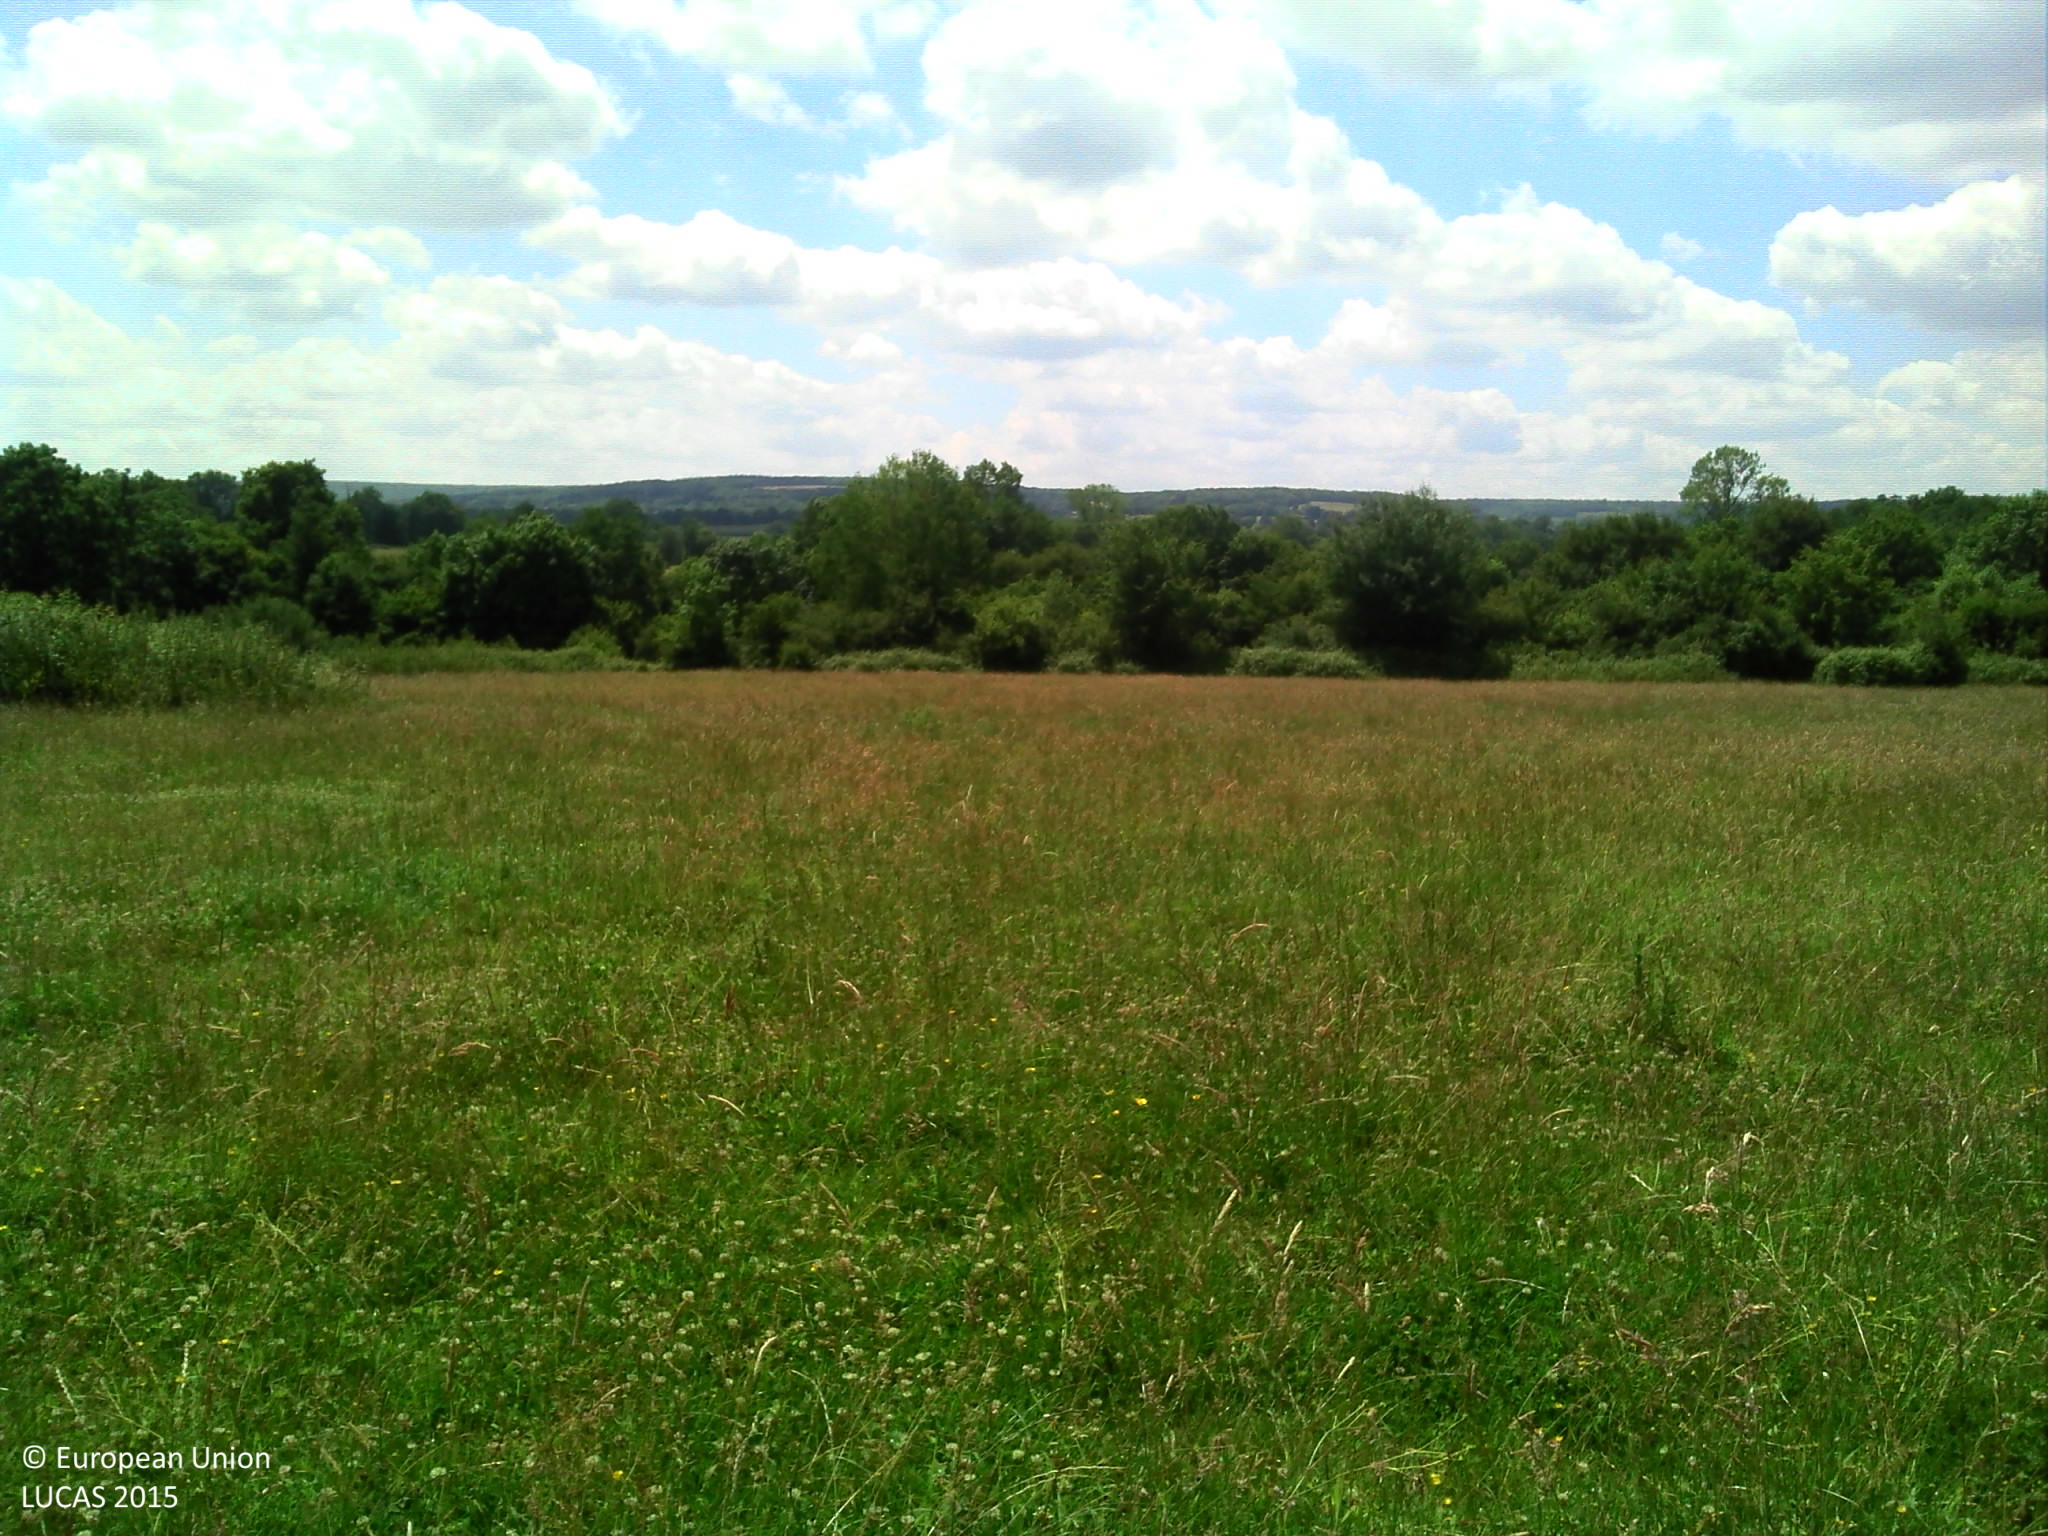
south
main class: Grassland
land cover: Grassland without tree/shrub cover
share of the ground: > 75 %
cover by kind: herbaceous plants 100 %
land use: Agriculture (excluding fallow land and kitchen gardens)
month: June
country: FR
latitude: 47.4008
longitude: 2.6656
